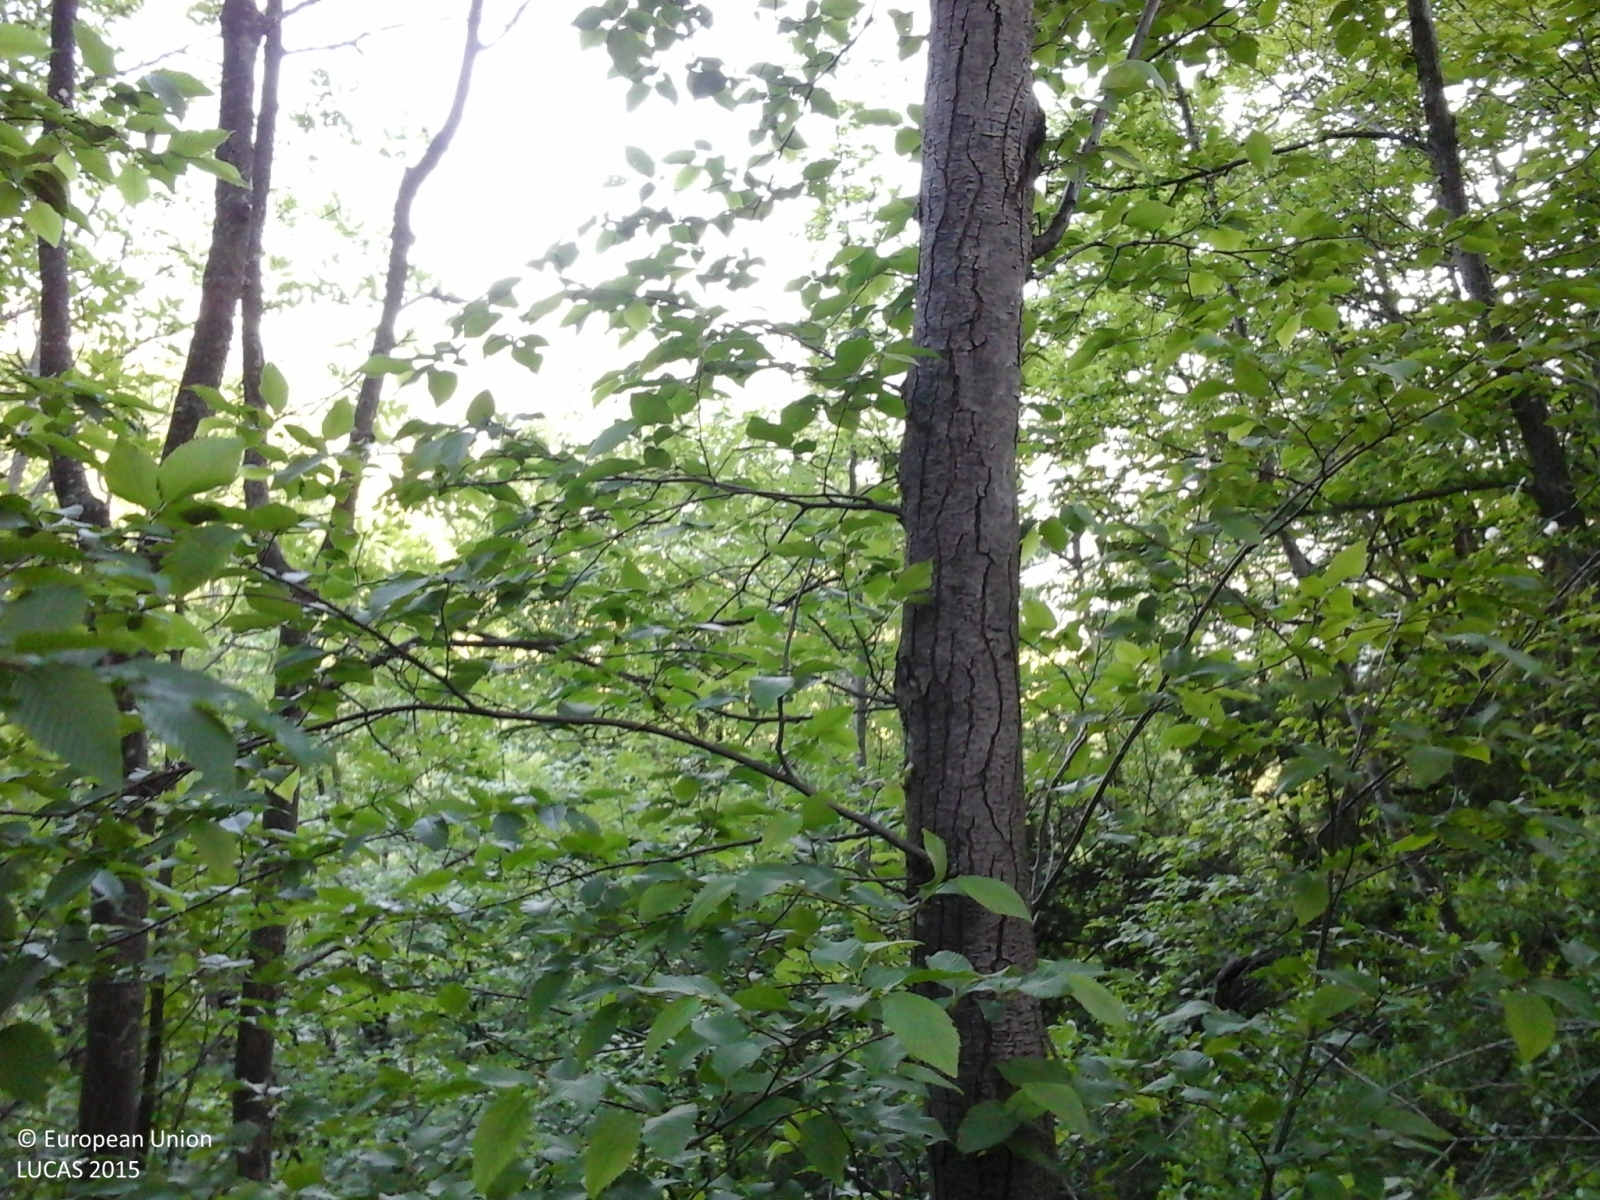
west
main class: Woodland
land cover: Broadleaved woodland
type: thermophilous deciduous forest
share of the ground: > 75 %
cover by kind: broadleaved forest trees 100 %
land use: Forestry
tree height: > 5 m
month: May
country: IT
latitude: 44.5309
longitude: 9.9121
